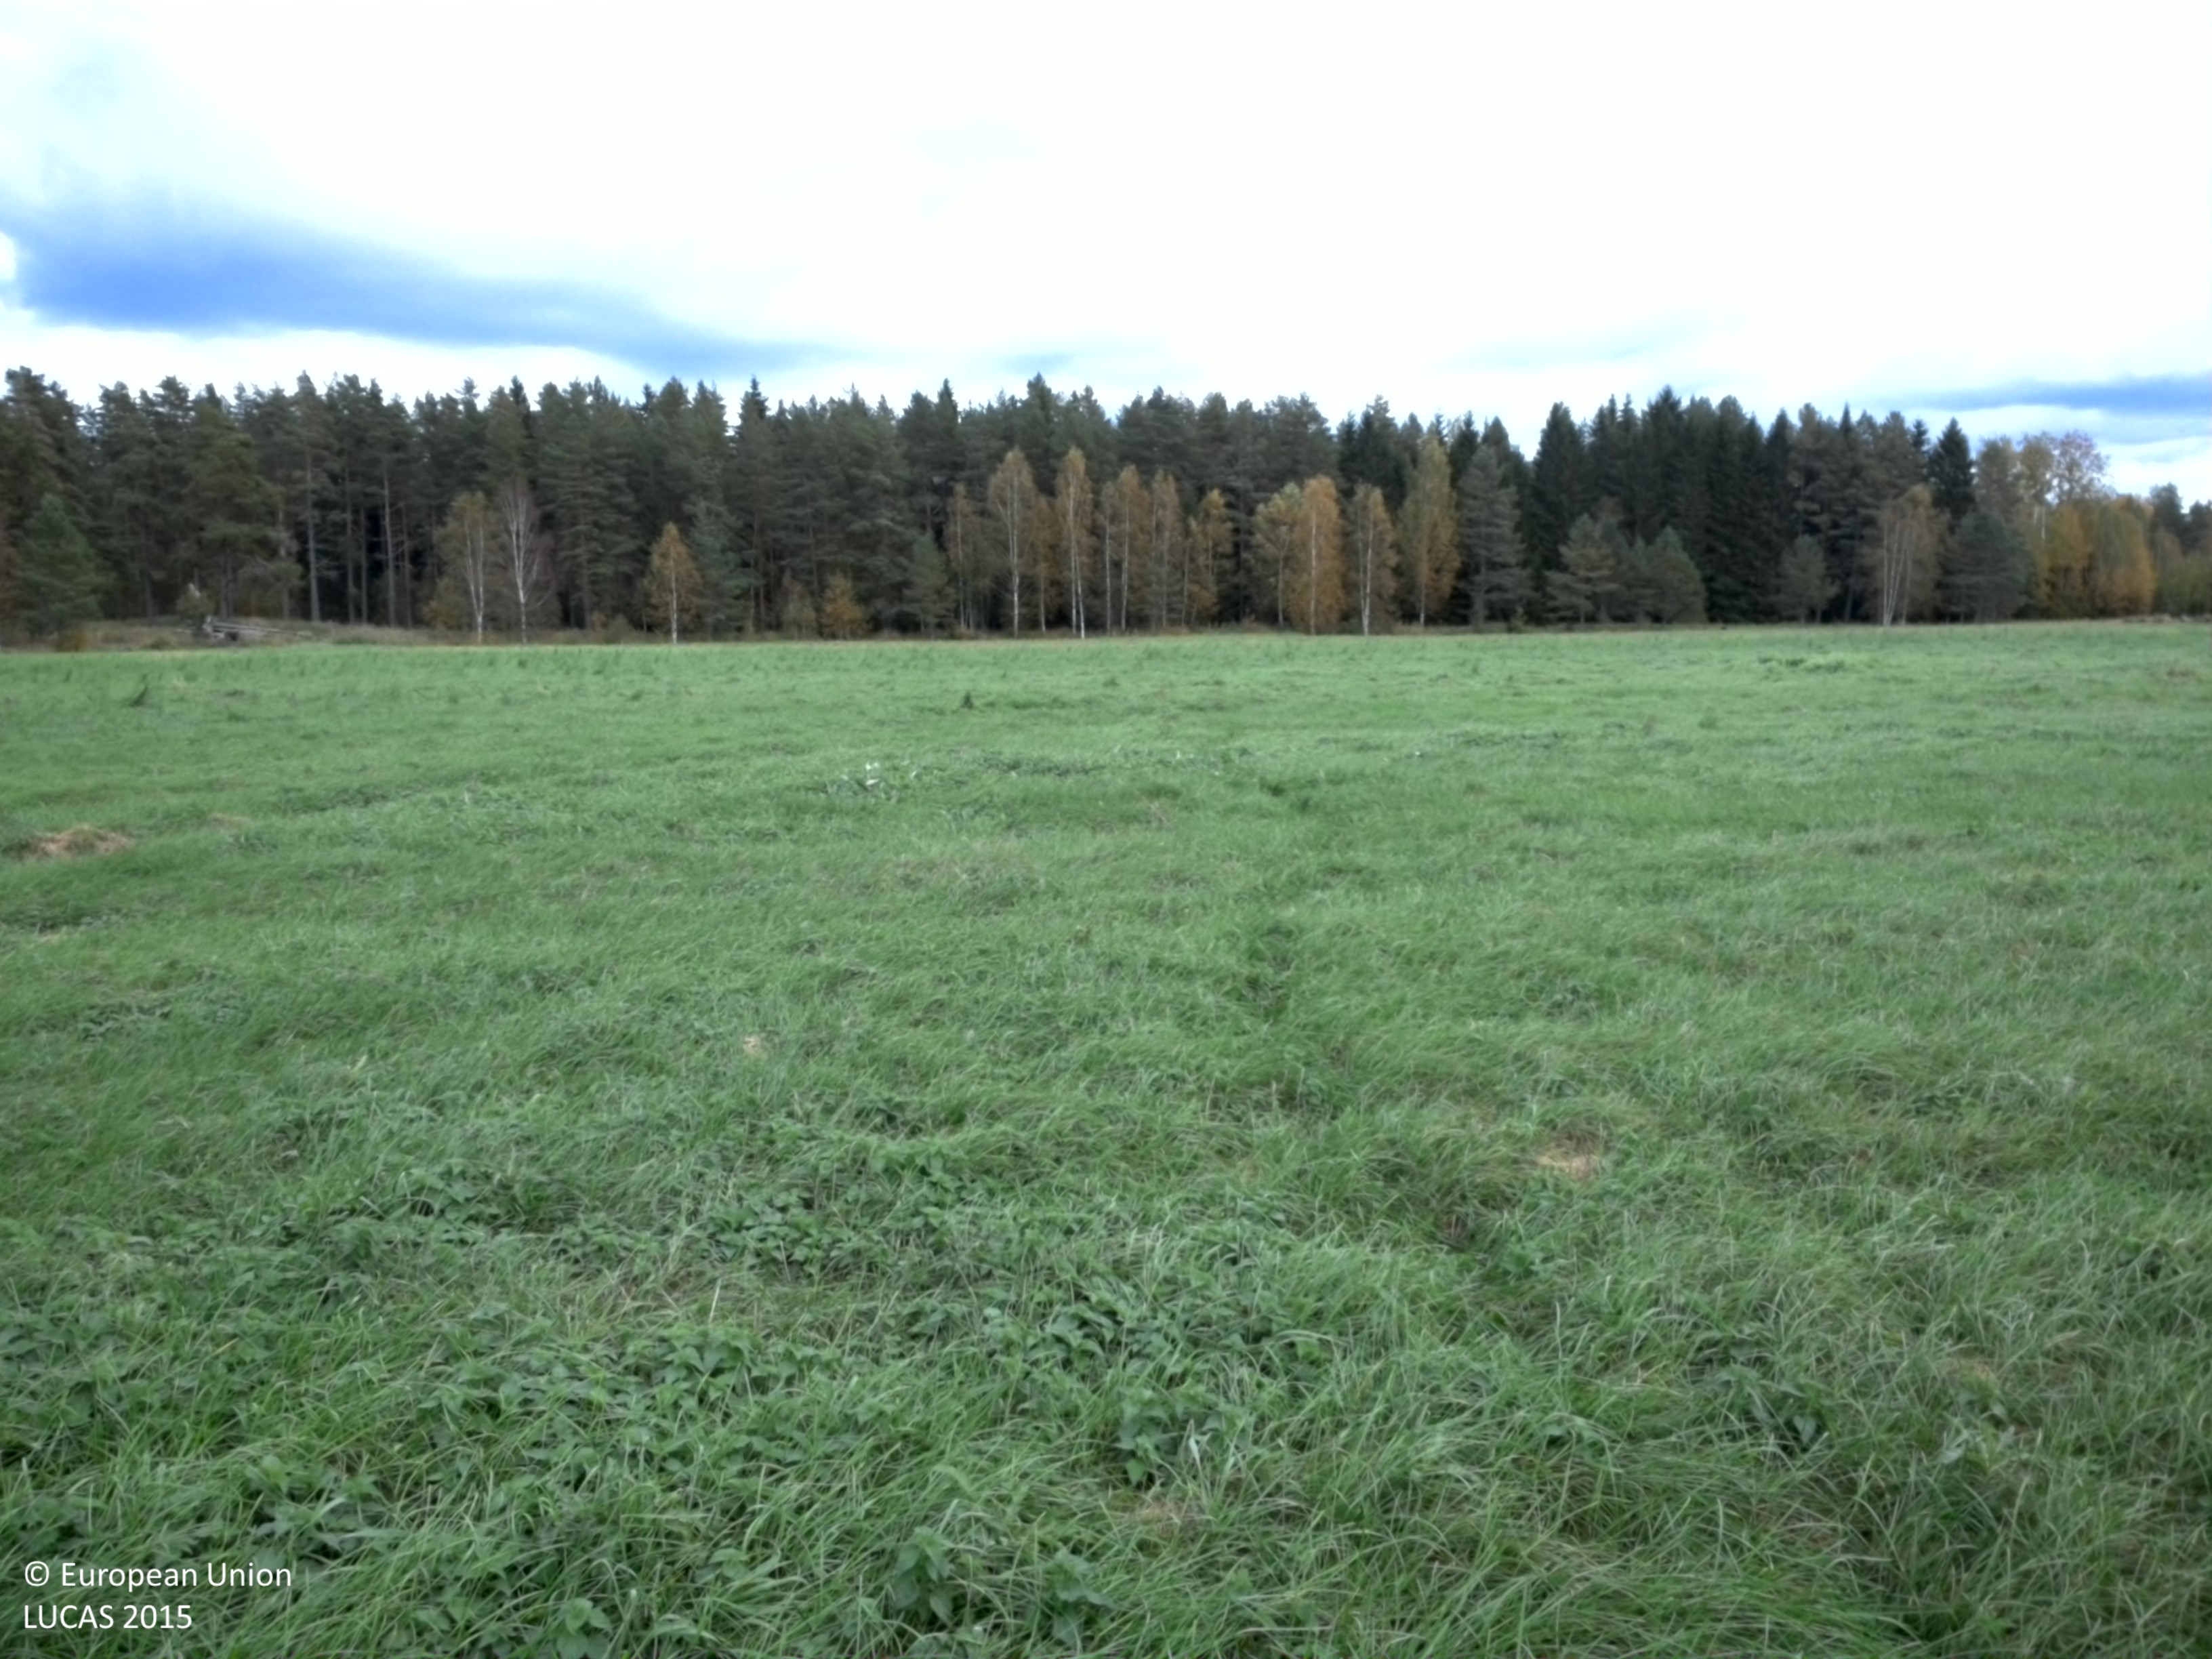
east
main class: Grassland
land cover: Grassland without tree/shrub cover
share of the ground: > 75 %
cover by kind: herbaceous plants 100 %
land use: Agriculture (excluding fallow land and kitchen gardens)
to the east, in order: Grassland without tree/shrub cover; Ditches and canals; Pine dominated mixed woodland; Fences; Pine dominated coniferous woodland; Fences; Pine dominated mixed woodland
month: September
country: SE
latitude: 60.1874
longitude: 17.0054
